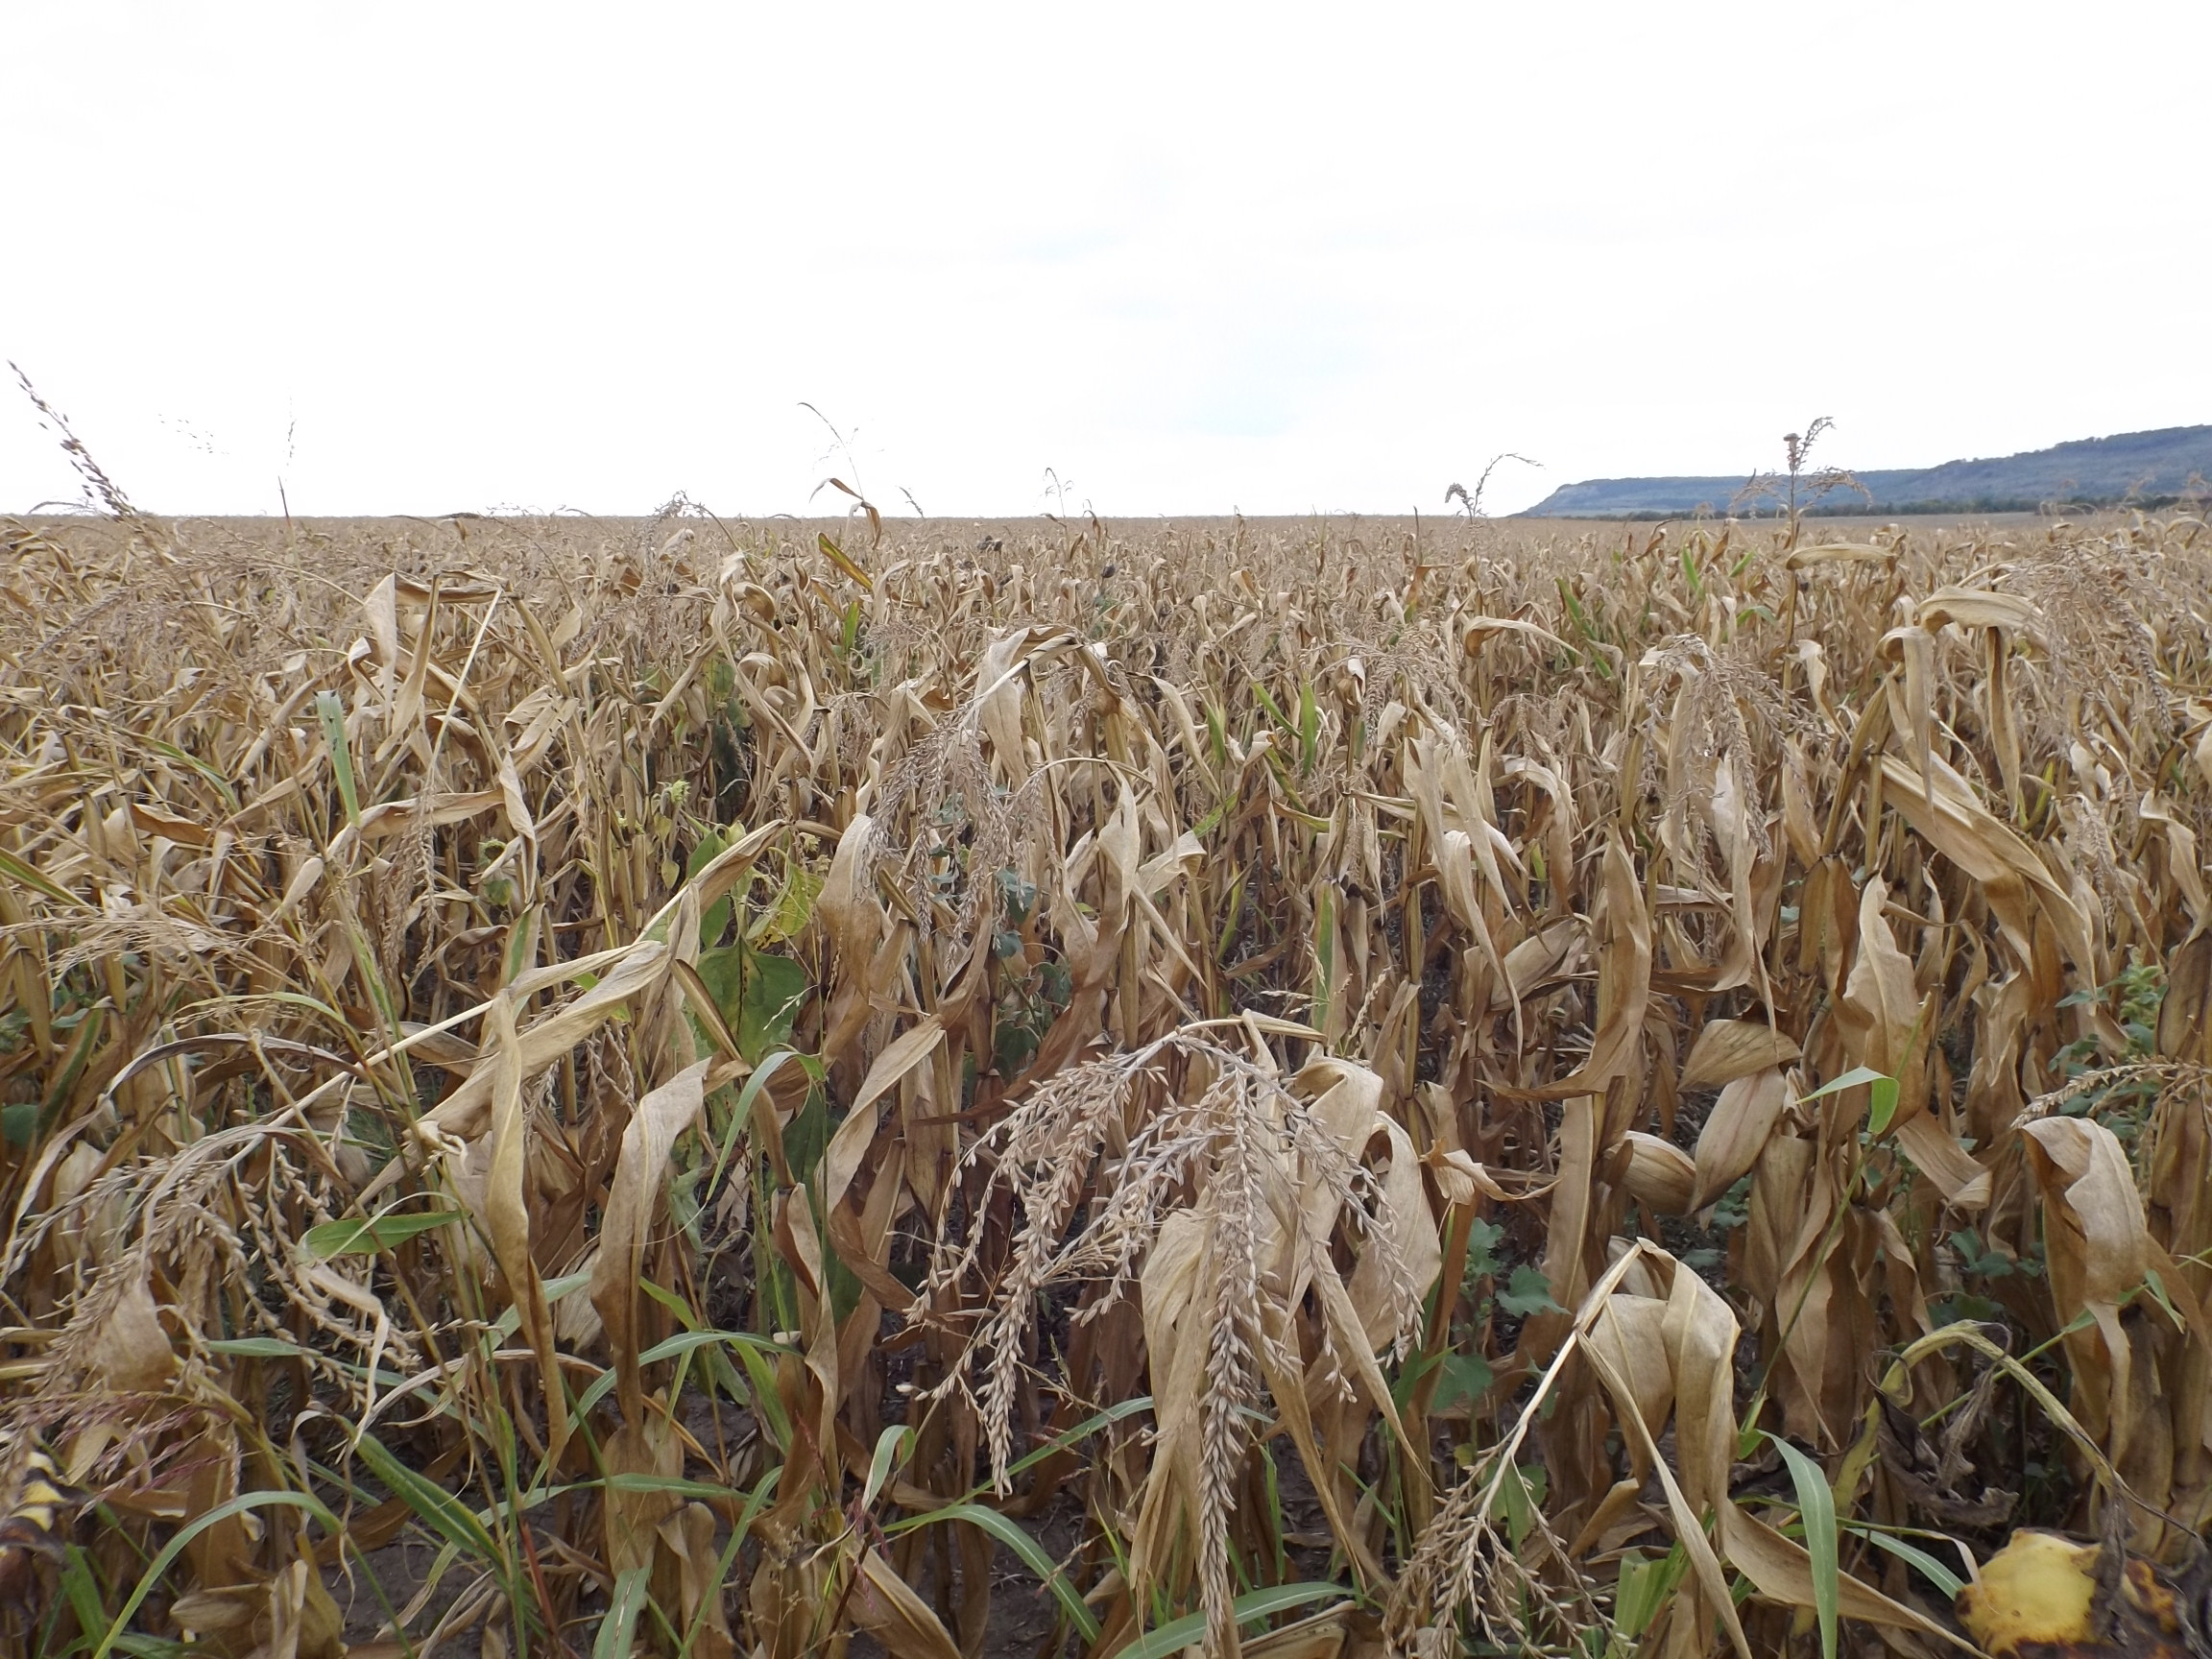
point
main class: Cropland
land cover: Maize
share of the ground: > 75 %
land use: Agriculture (excluding fallow land and kitchen gardens)
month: August
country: BG
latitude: 43.2539
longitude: 27.6096
